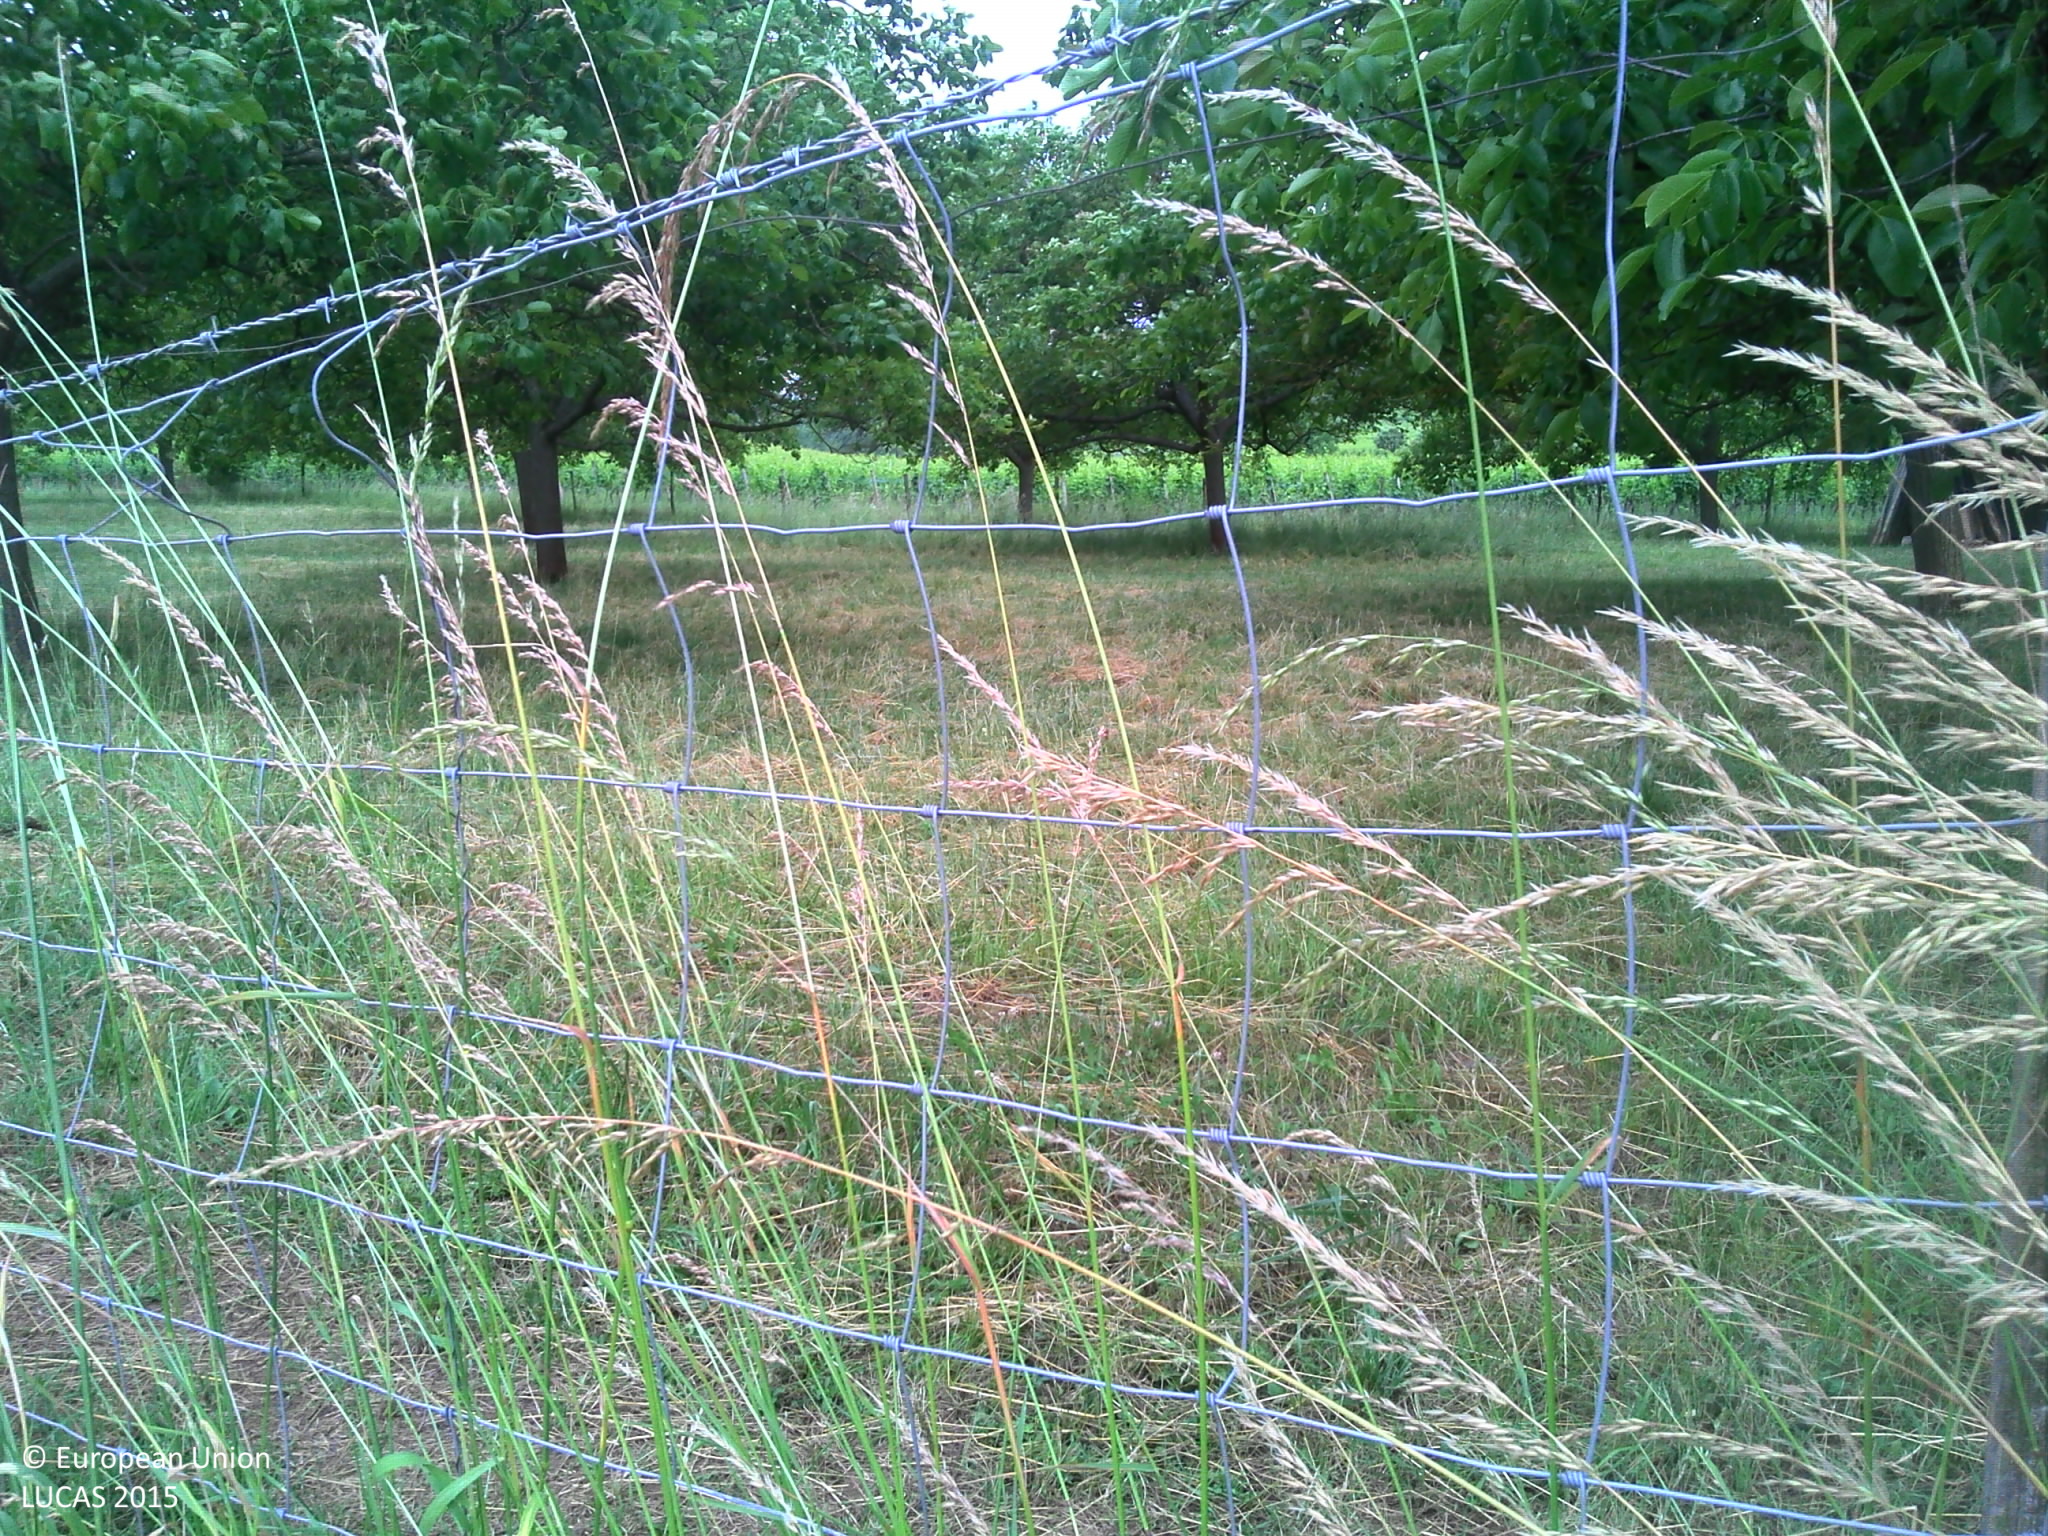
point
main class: Cropland
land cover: Nuts trees
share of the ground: > 75 %
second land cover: Grassland without tree/shrub cover
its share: > 75 %
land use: Agriculture (excluding fallow land and kitchen gardens)
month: June
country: FR
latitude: 48.5186
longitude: 7.4691
